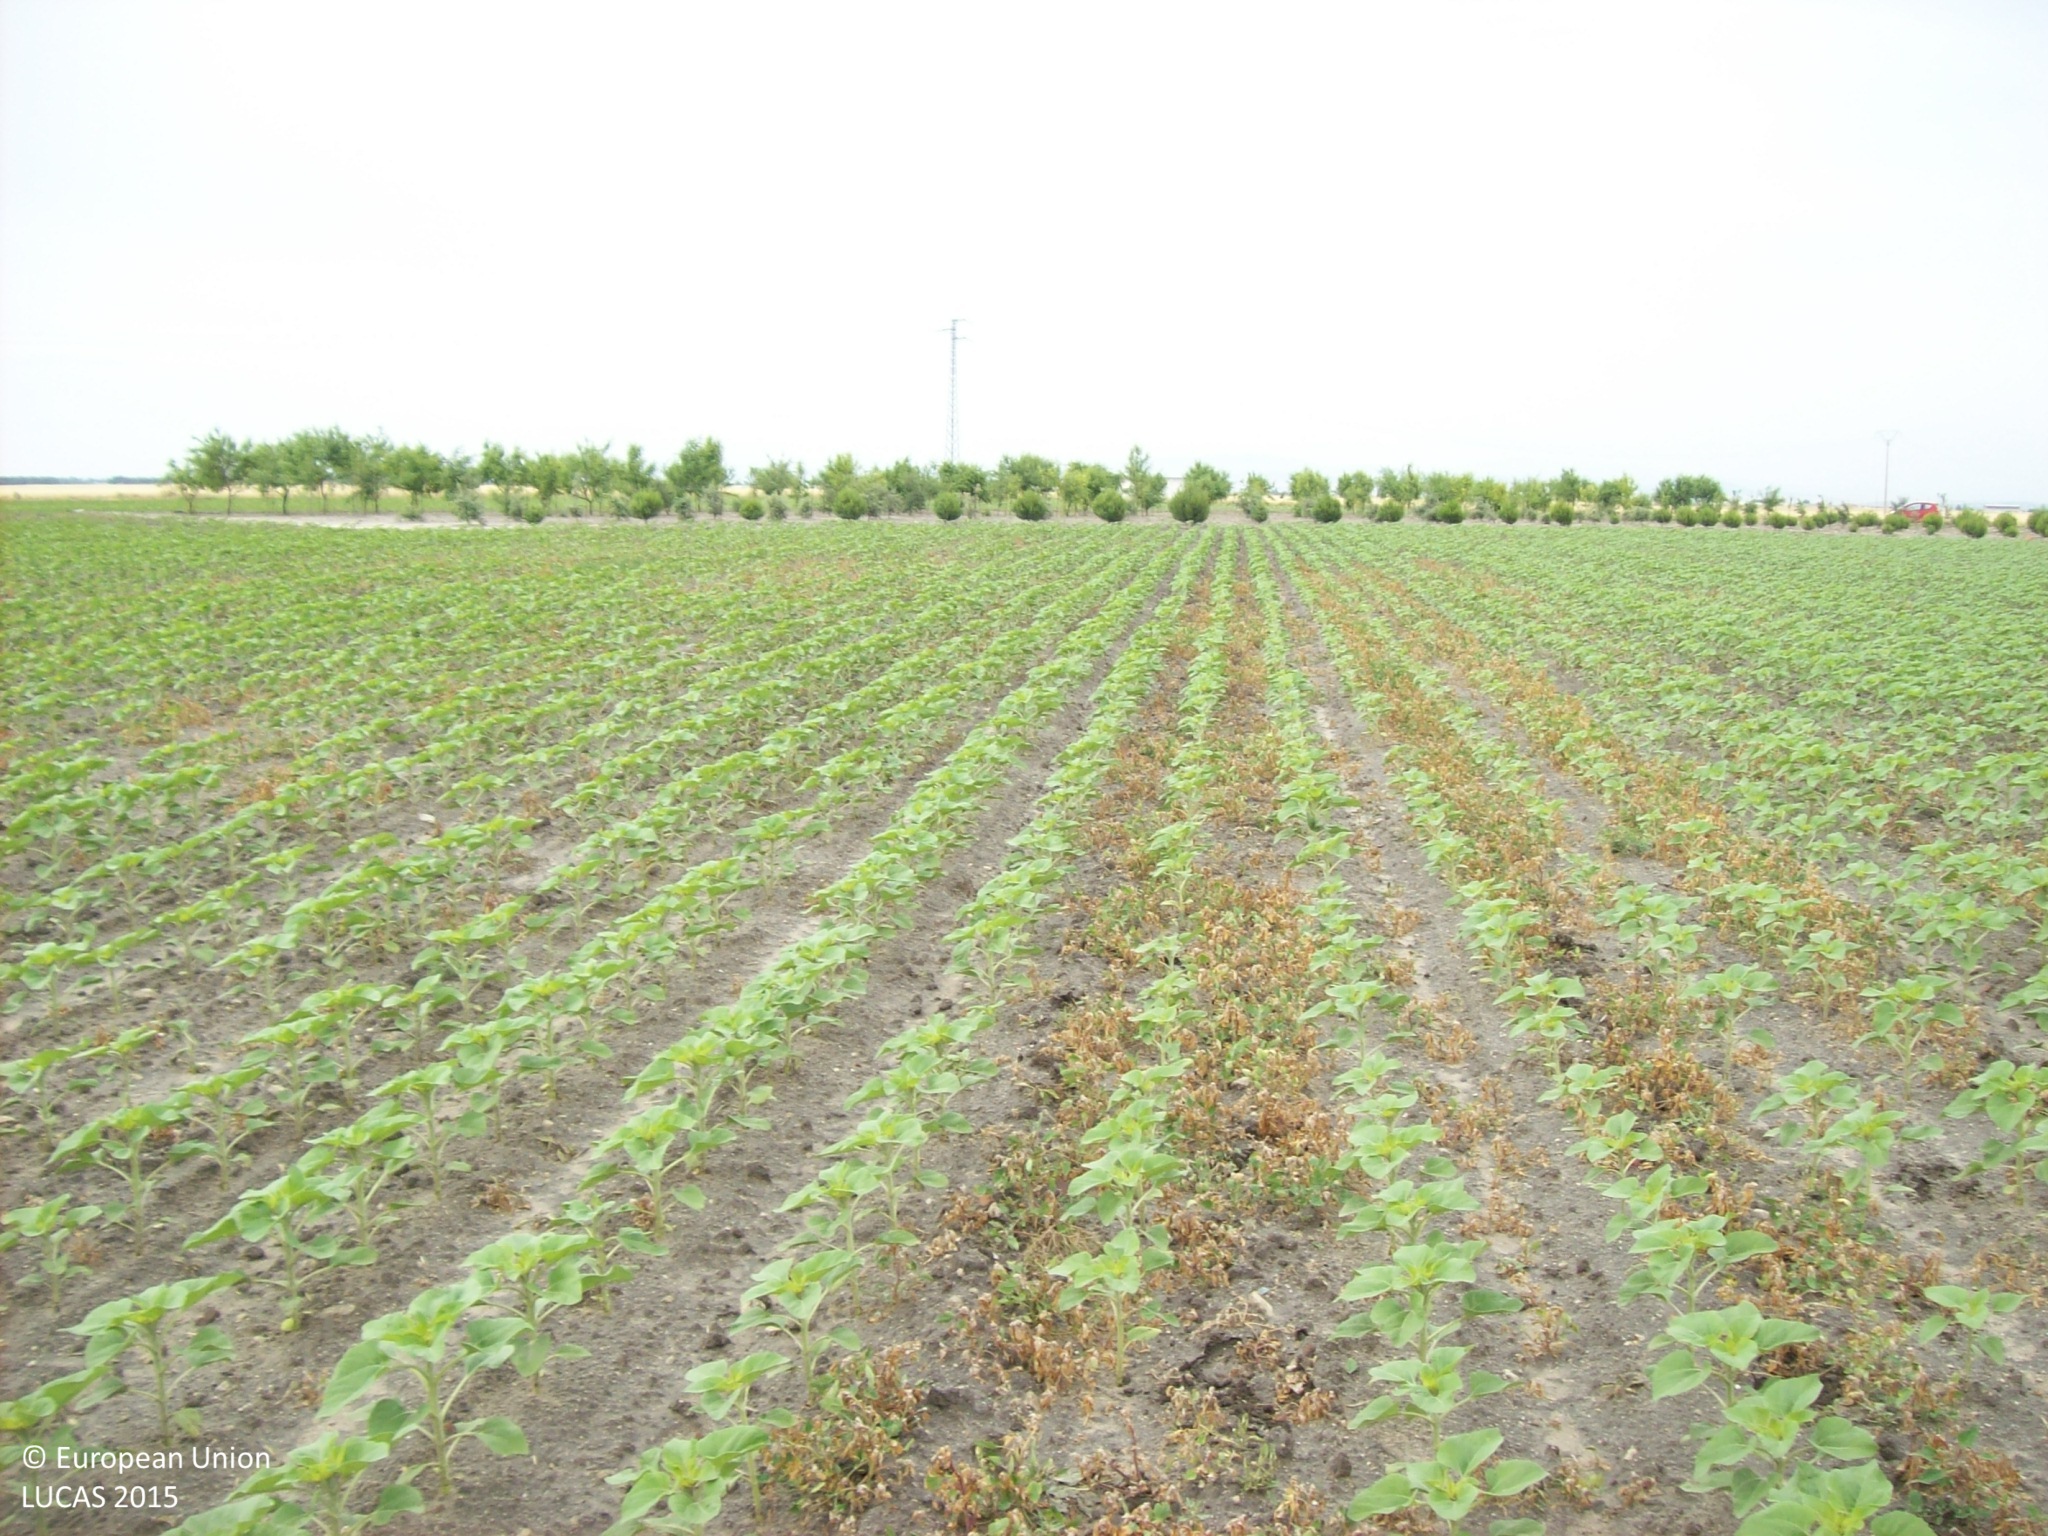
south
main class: Cropland
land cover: Sunflower
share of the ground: 50 - 75 %
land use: Agriculture (excluding fallow land and kitchen gardens)
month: June
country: ES
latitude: 40.9505
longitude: -4.9489
